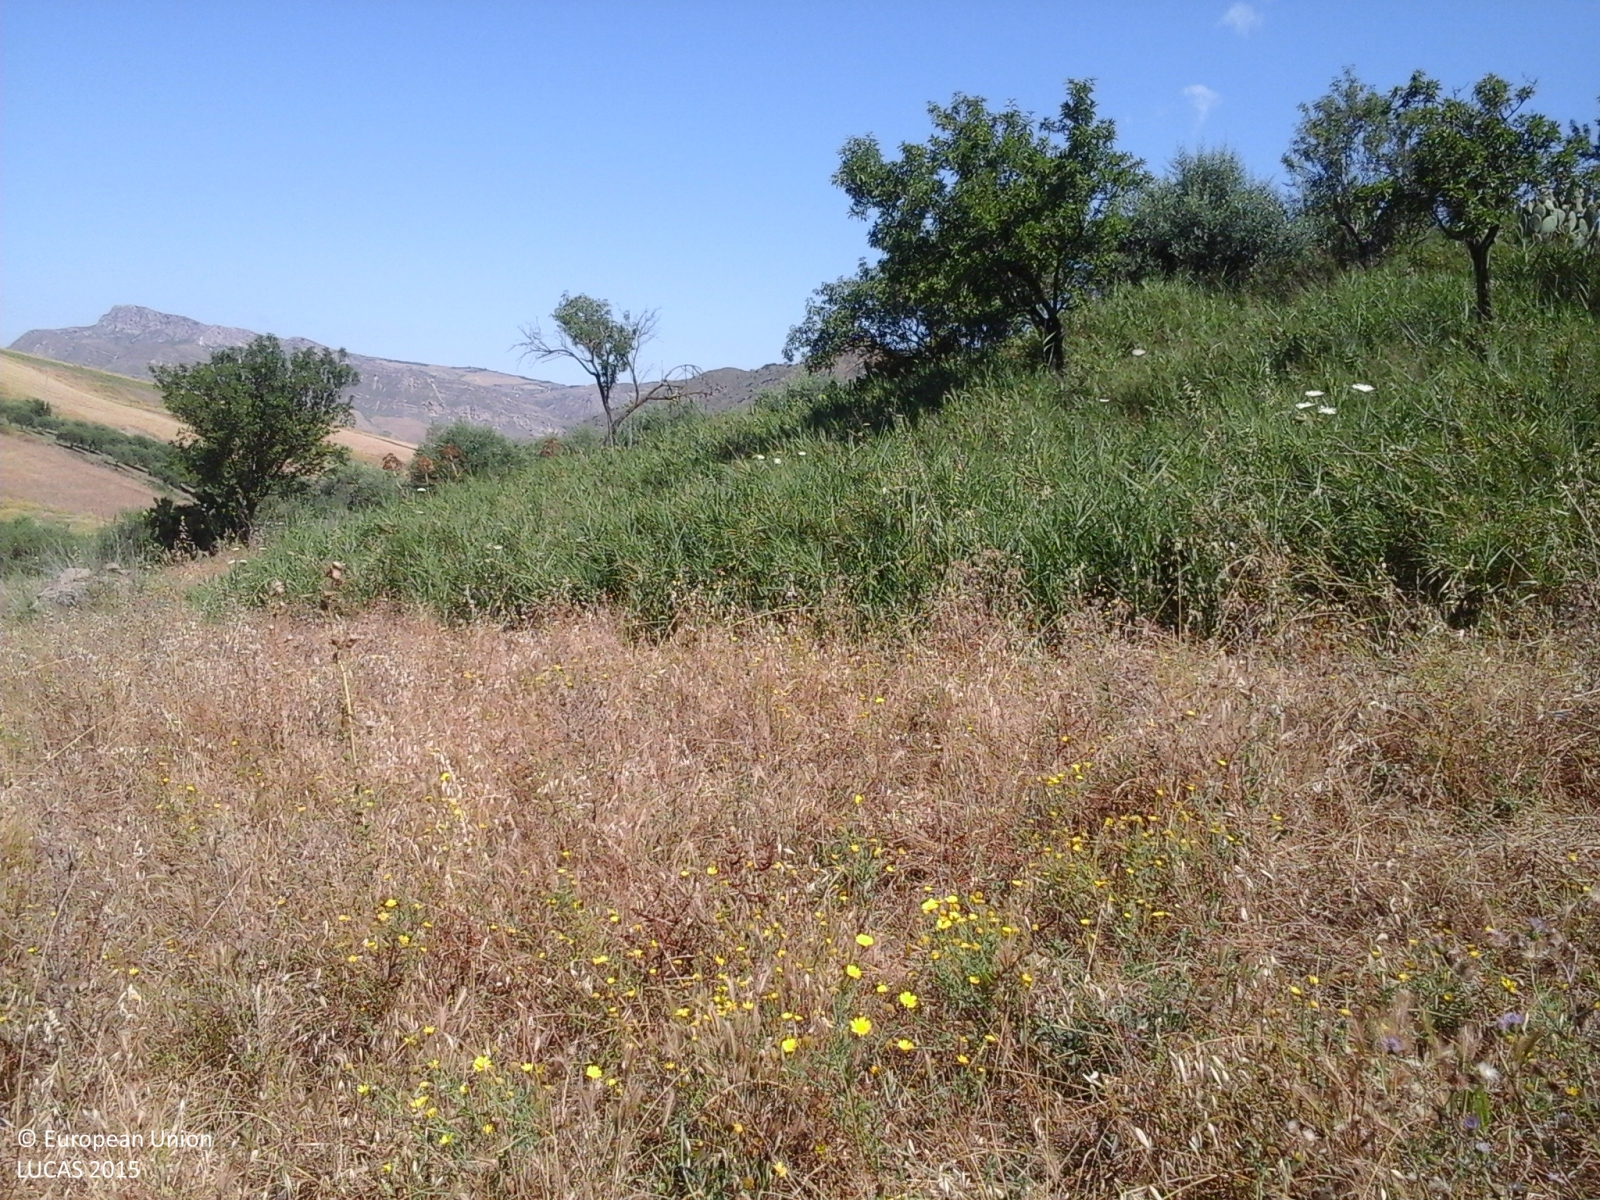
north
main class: Grassland
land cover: Spontaneously vegetated surfaces
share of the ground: > 75 %
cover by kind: herbaceous plants 100 %
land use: Fallow land
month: June
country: IT
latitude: 37.8240
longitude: 13.6206
